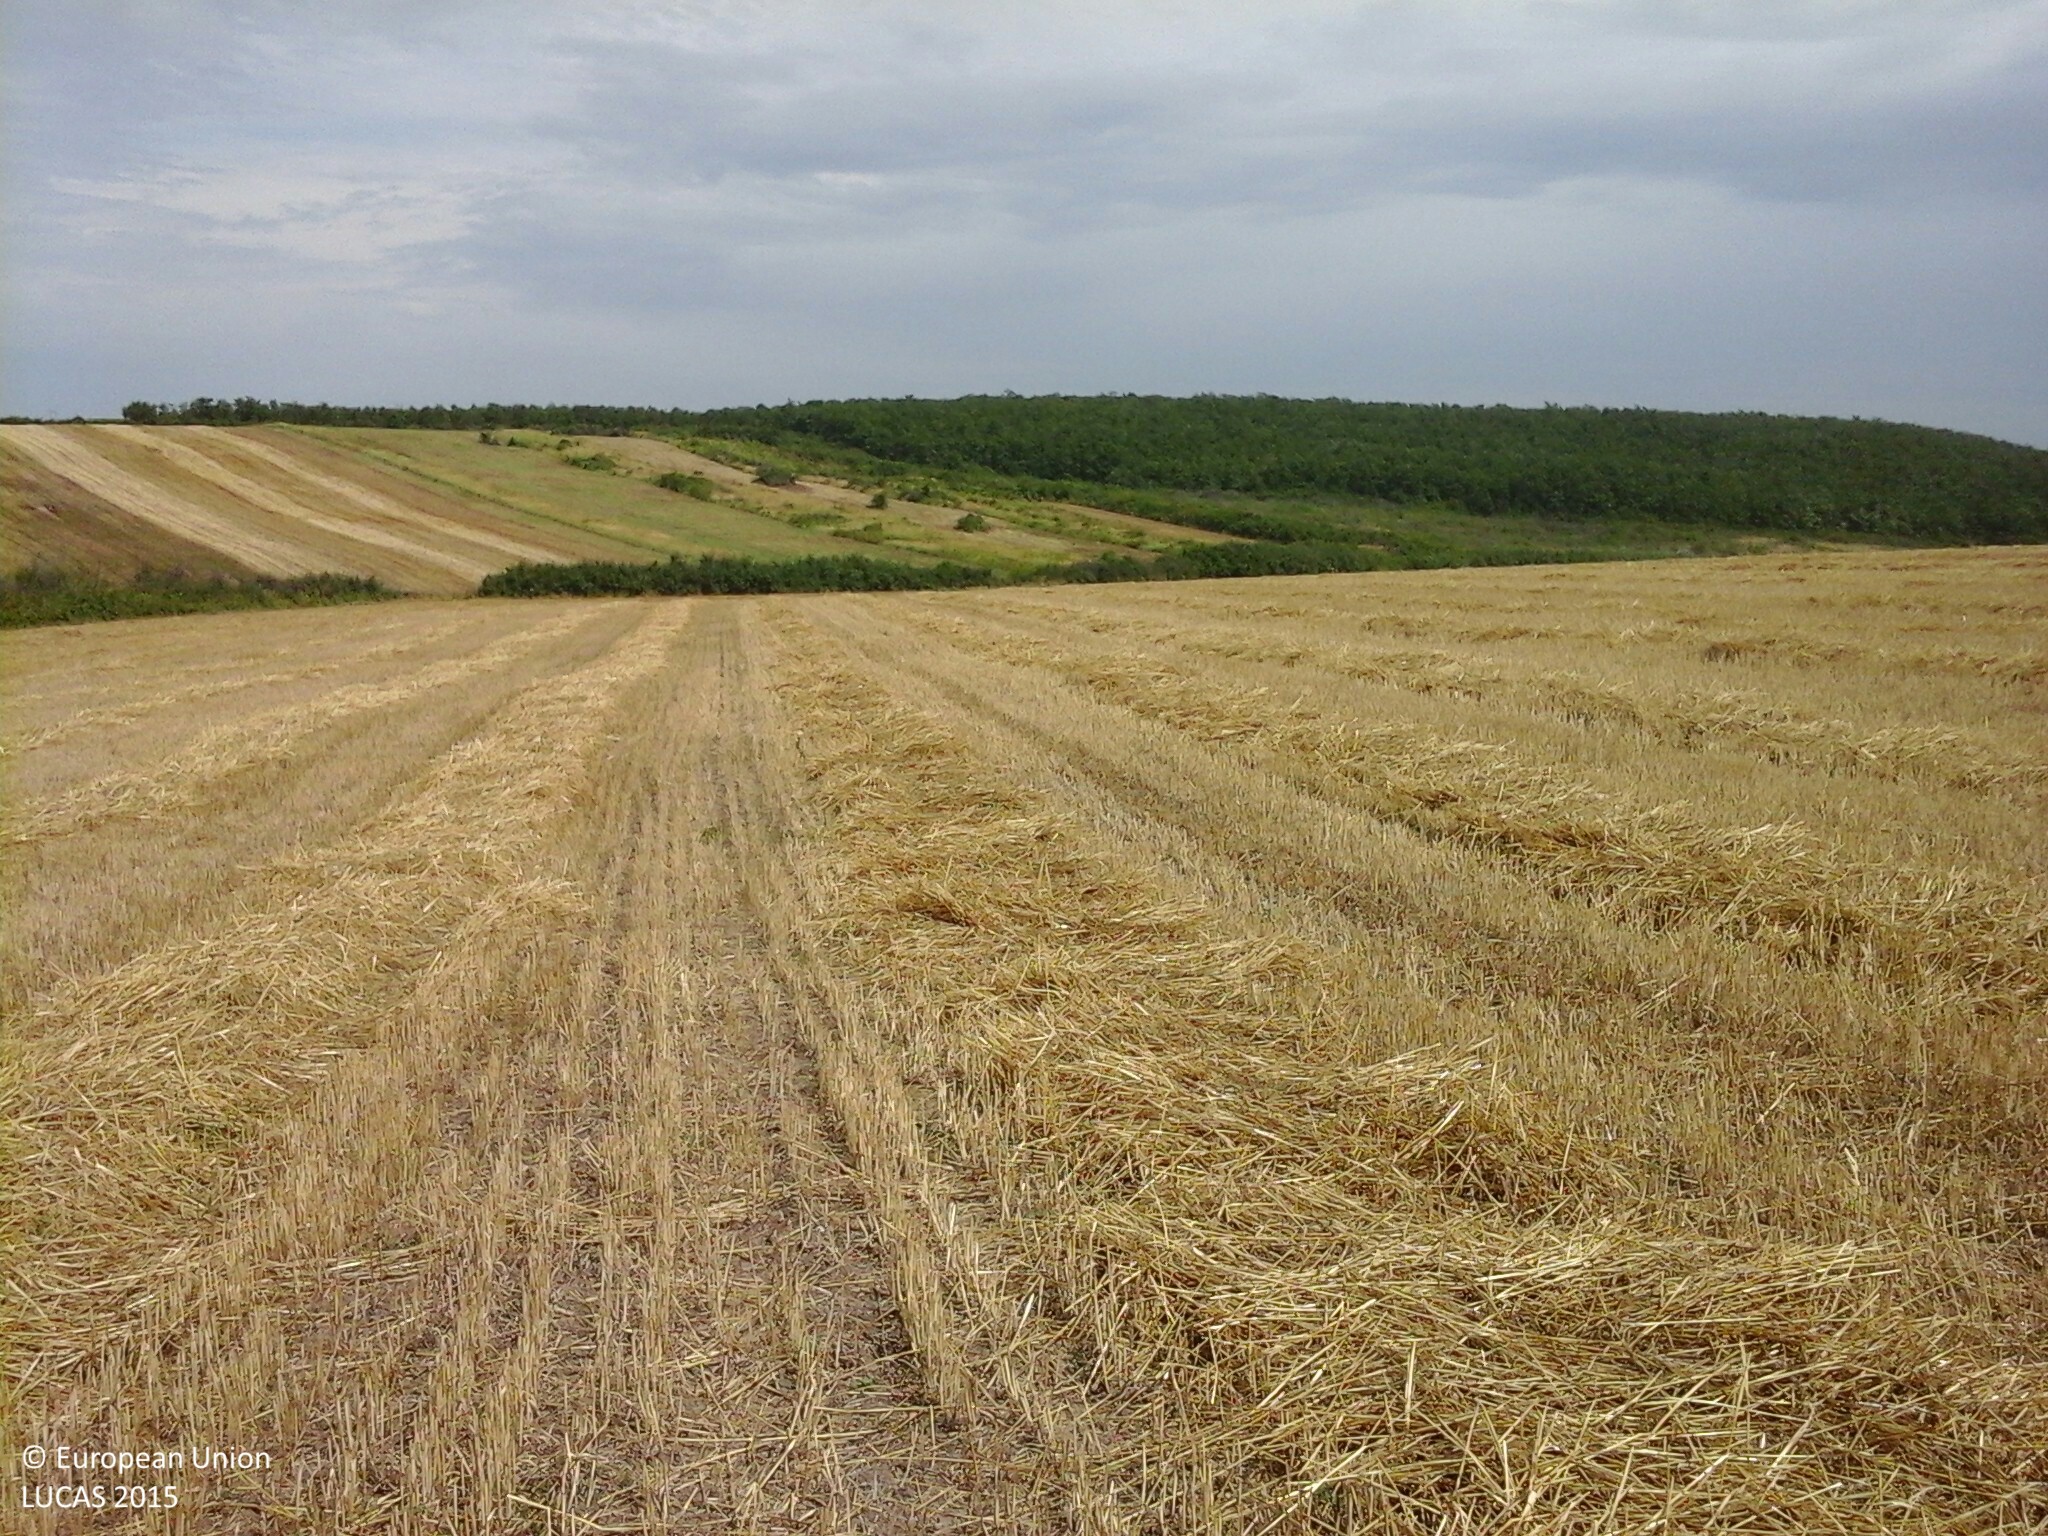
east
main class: Cropland
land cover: Common wheat
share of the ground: 50 - 75 %
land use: Agriculture (excluding fallow land and kitchen gardens)
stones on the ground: < 10 %
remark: Harvested field
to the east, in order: Common wheat; Shrubland without tree cover
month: July
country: HU
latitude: 47.9420
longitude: 20.6509
